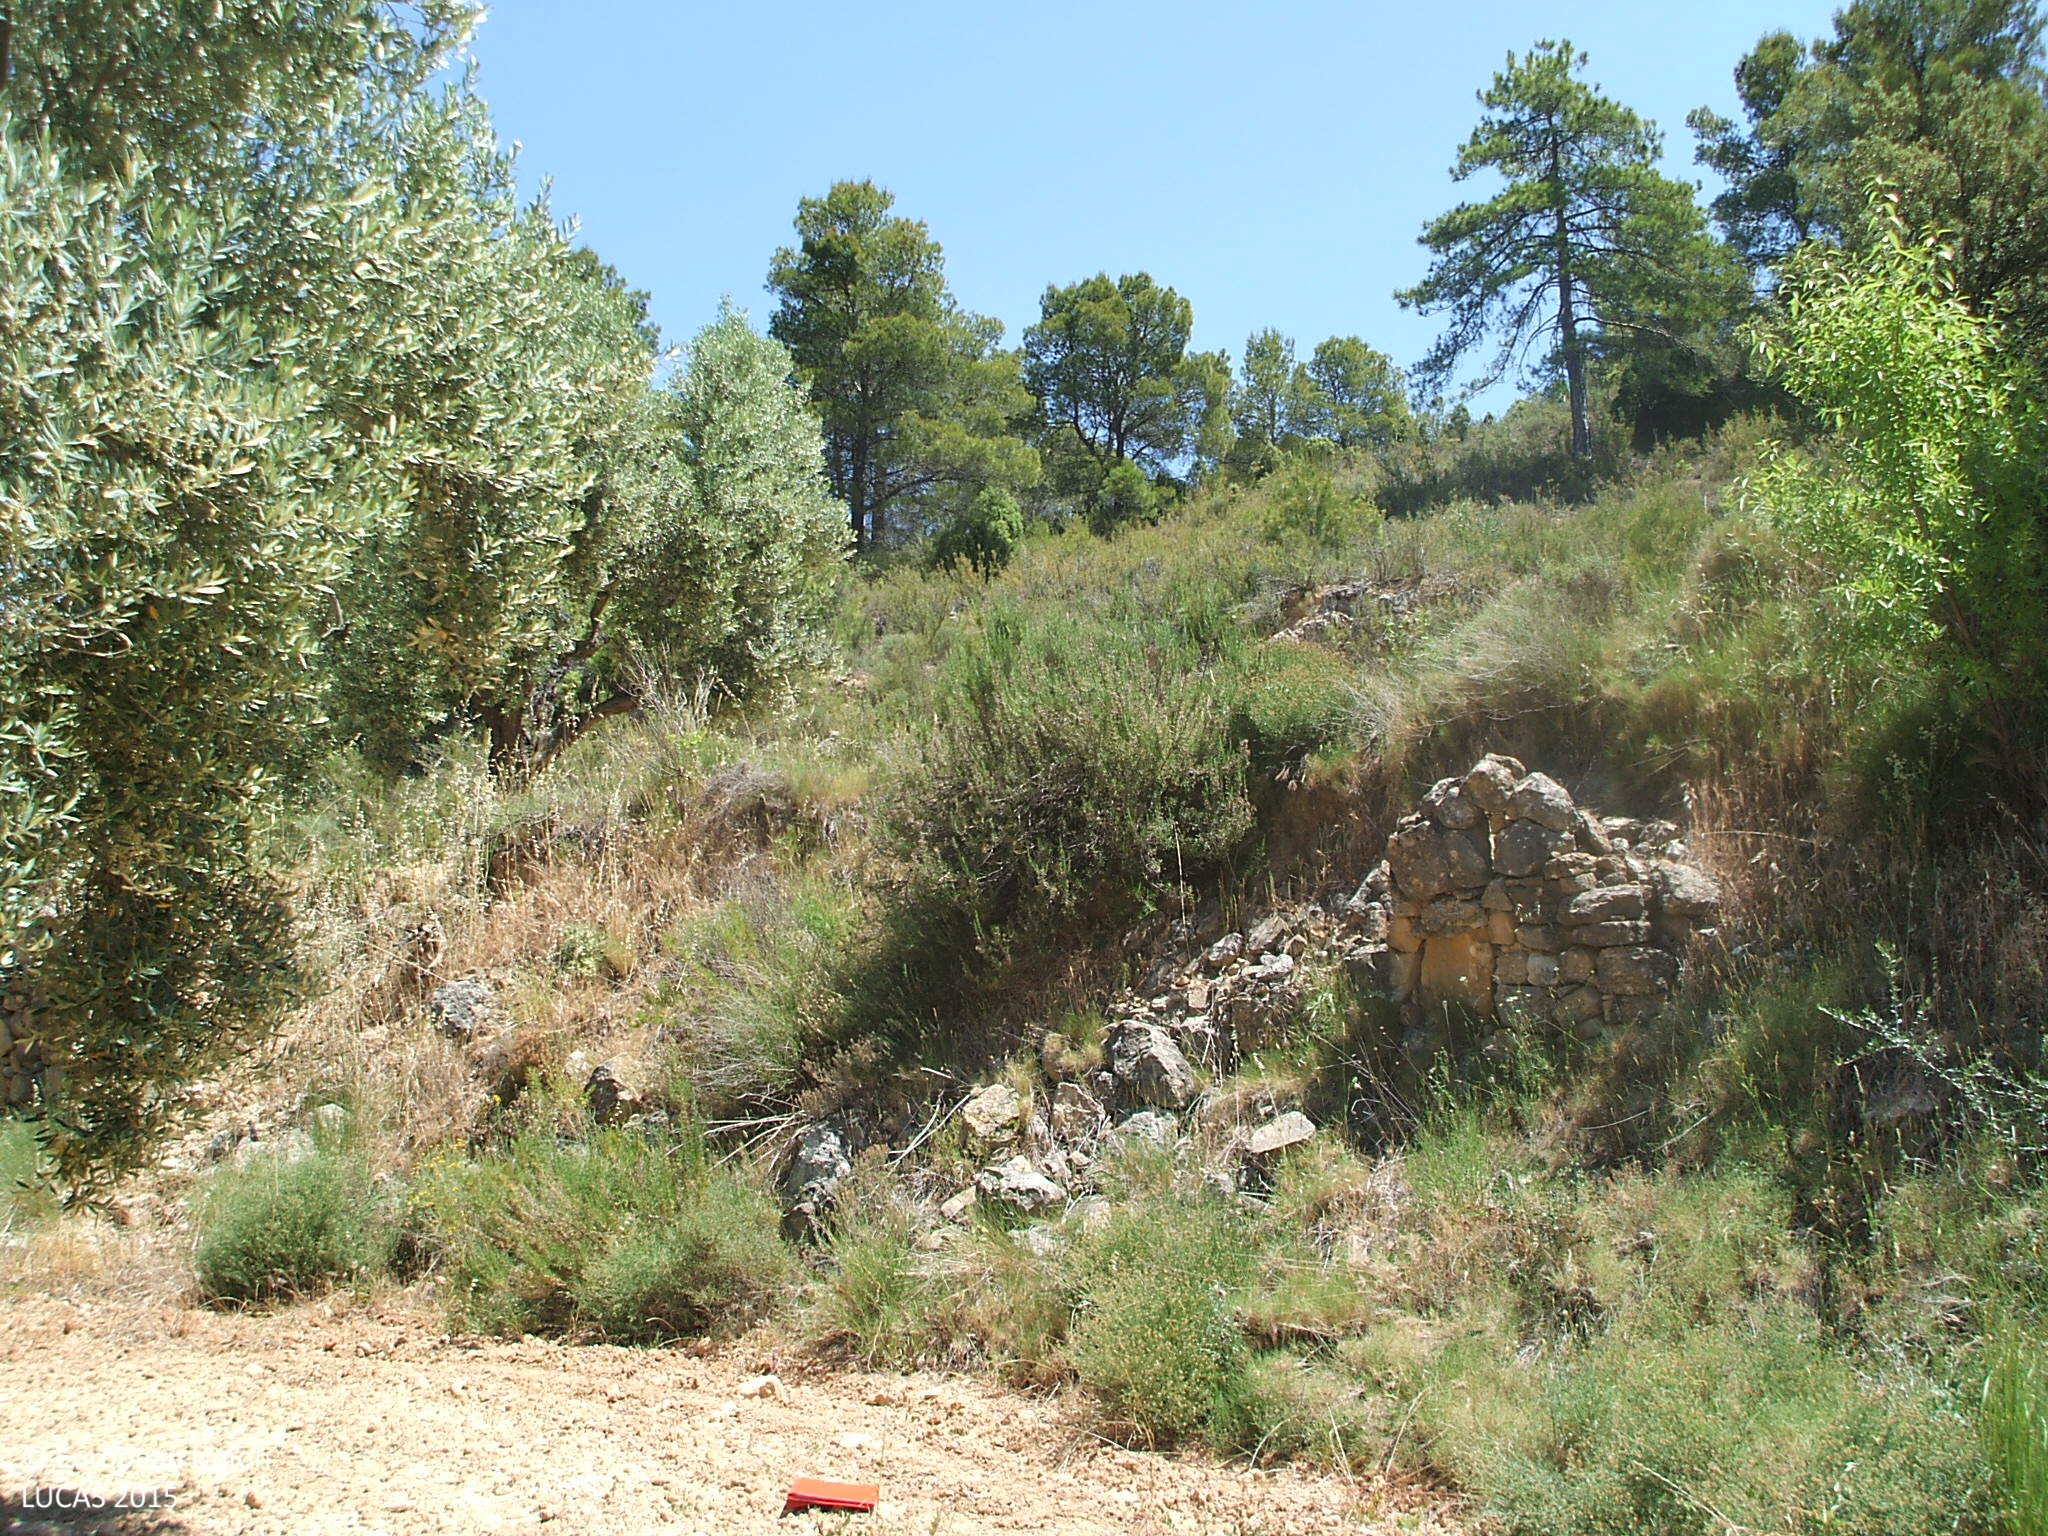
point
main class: Cropland
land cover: Olive groves
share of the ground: 10 - 25 %
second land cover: Other bare soil
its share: > 75 %
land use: Agriculture (excluding fallow land and kitchen gardens)
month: June
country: ES
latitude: 40.8316
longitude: 0.0185
